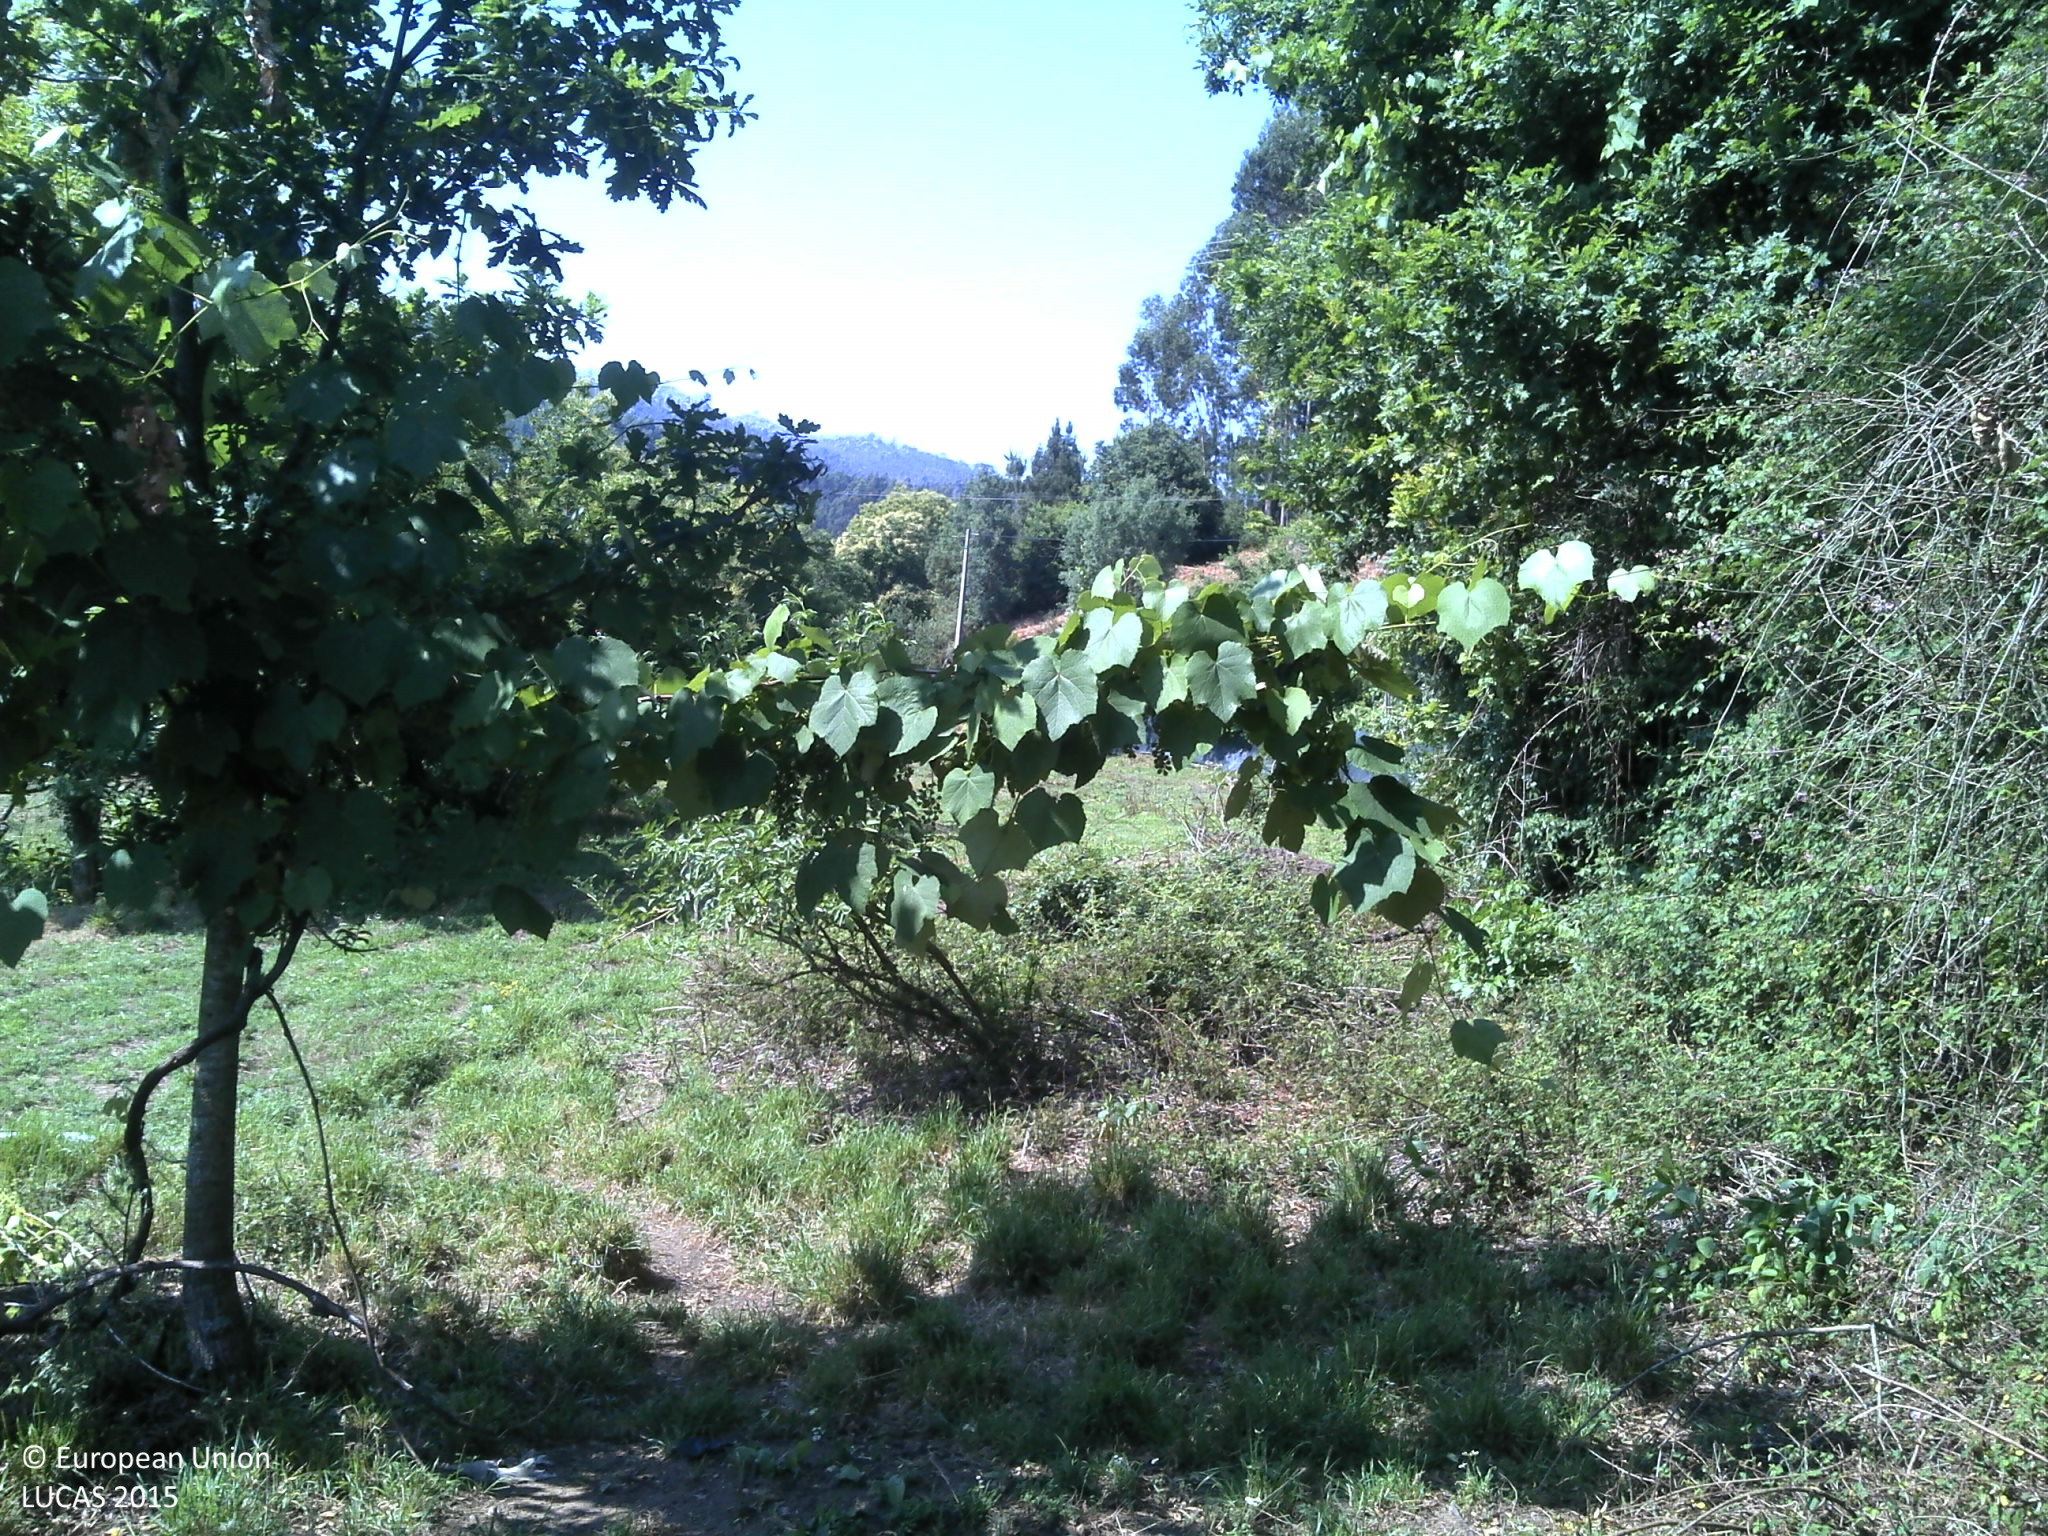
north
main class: Woodland
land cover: Broadleaved woodland
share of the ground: 25 - 50 %
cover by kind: broadleaved forest trees 50 %, shrubs 30 %, consolidated bare surface 10 %, unconsolidated bare surface 10 %
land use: Semi-natural and natural areas not in use
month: June
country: PT
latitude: 40.6794
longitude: -8.2721
